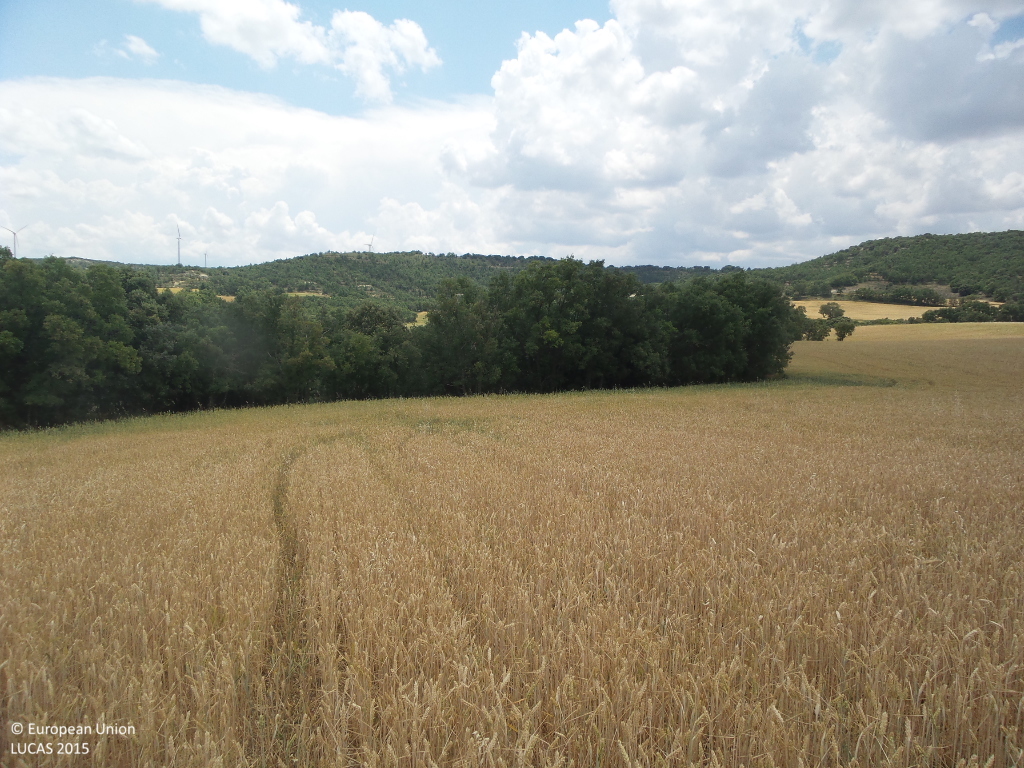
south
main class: Cropland
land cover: Common wheat
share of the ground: > 75 %
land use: Agriculture (excluding fallow land and kitchen gardens)
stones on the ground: < 10 %
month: June
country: ES
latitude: 41.4445
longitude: -2.7370
